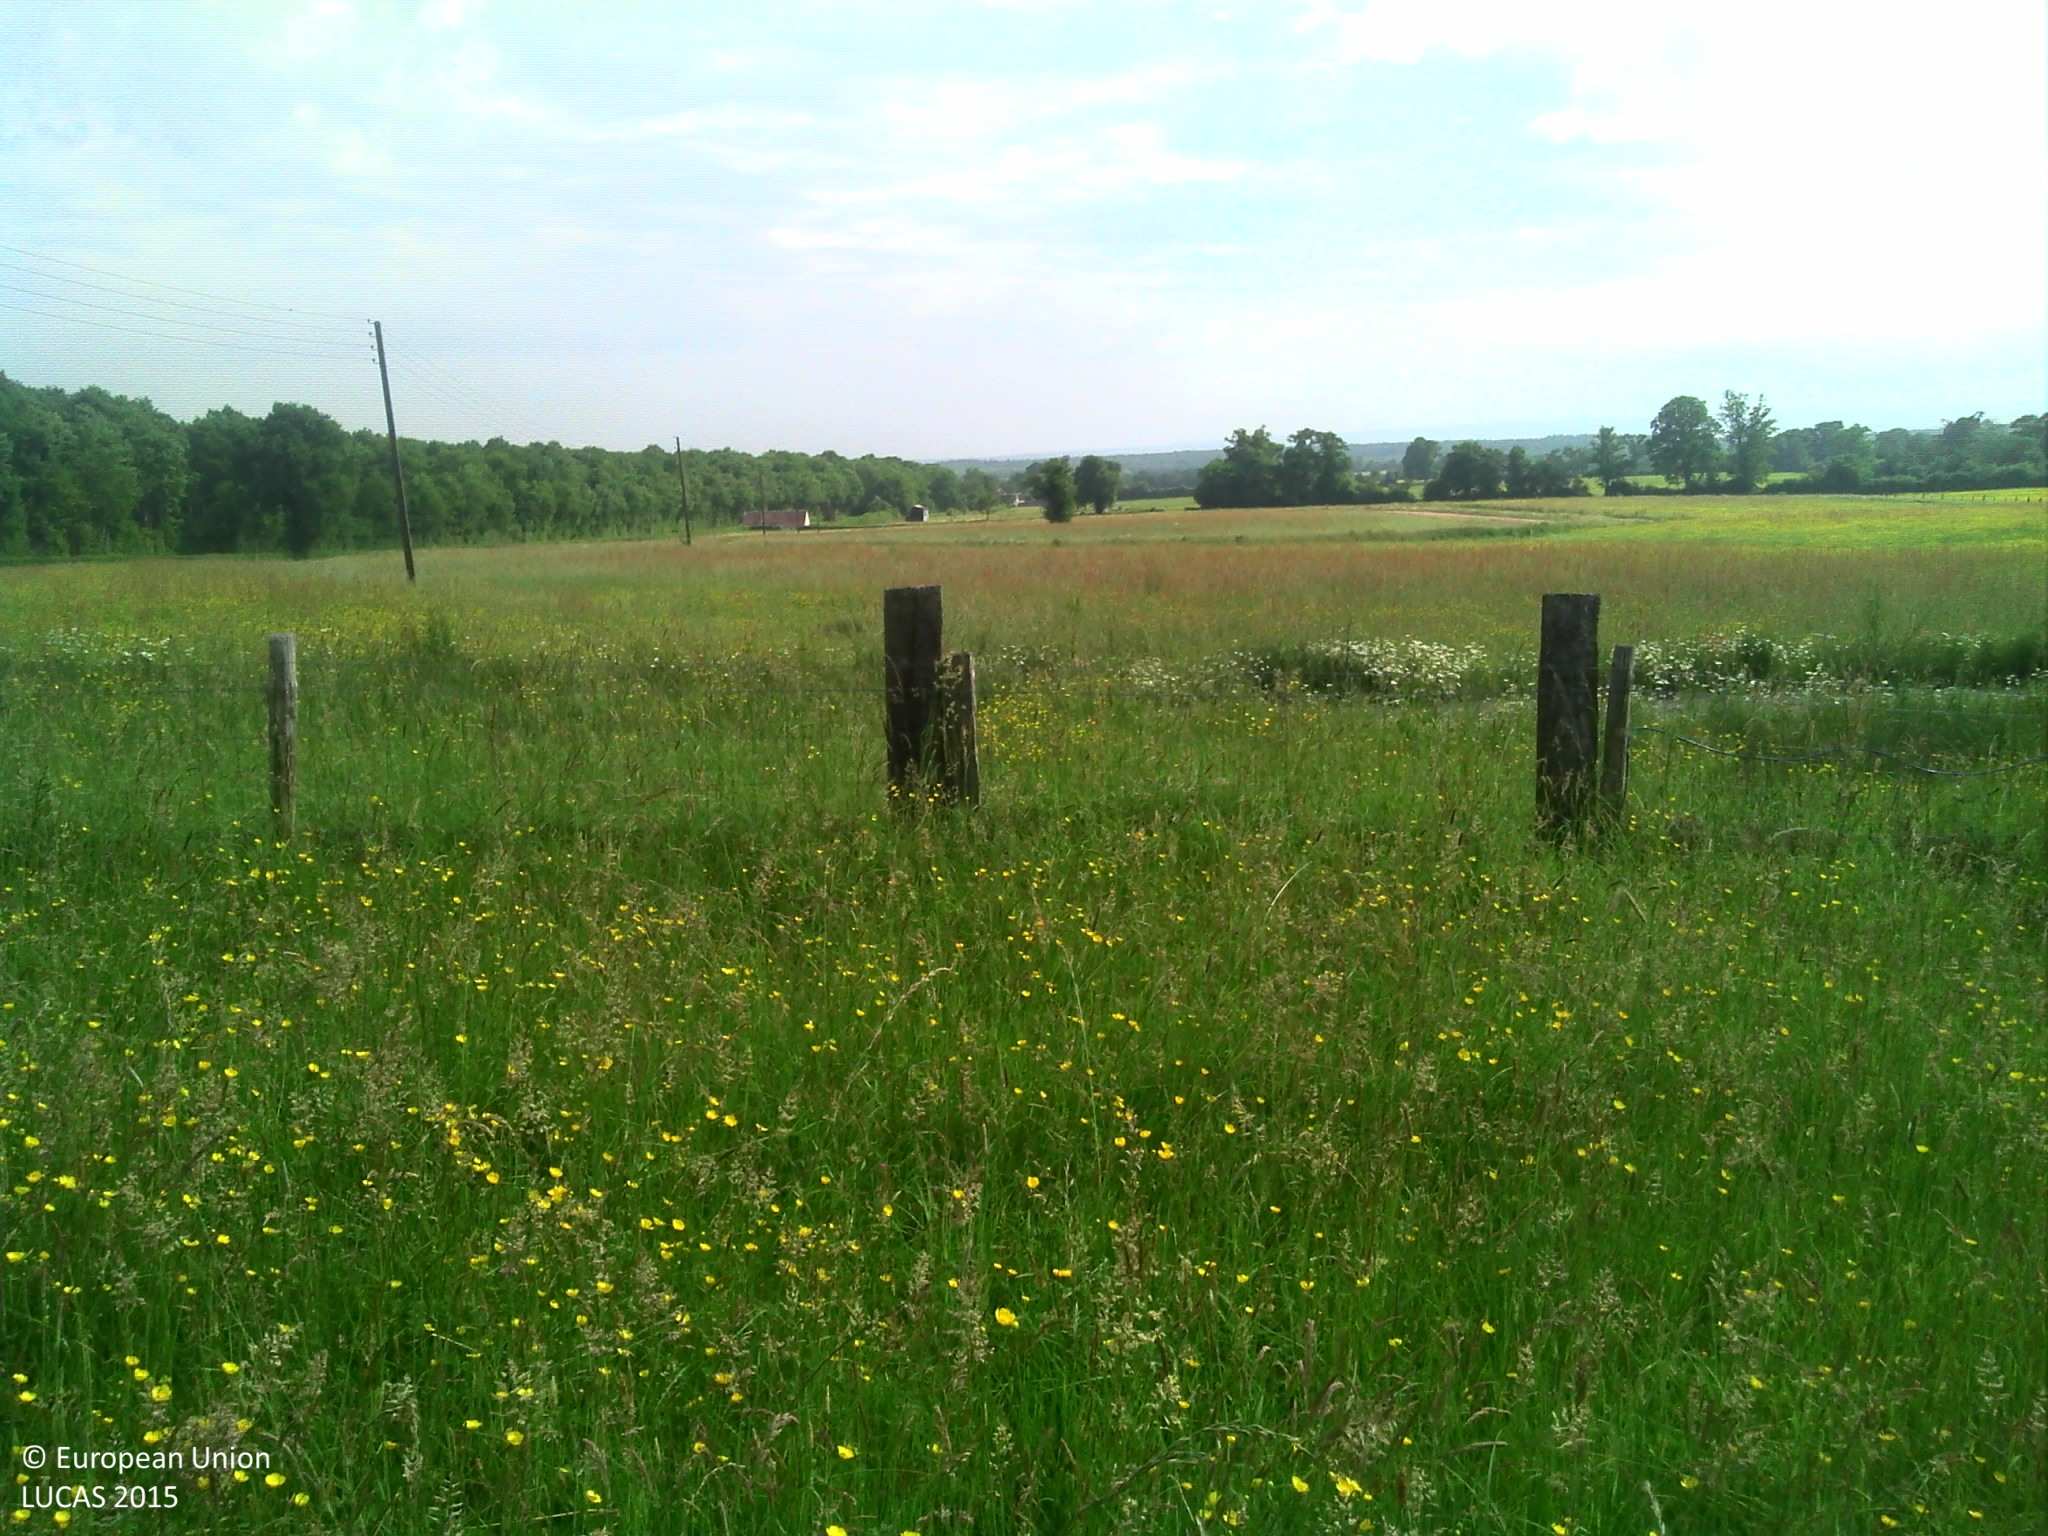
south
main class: Grassland
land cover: Grassland without tree/shrub cover
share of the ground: > 75 %
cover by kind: herbaceous plants 95 %
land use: Agriculture (excluding fallow land and kitchen gardens)
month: June
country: FR
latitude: 48.7055
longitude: 0.1467
